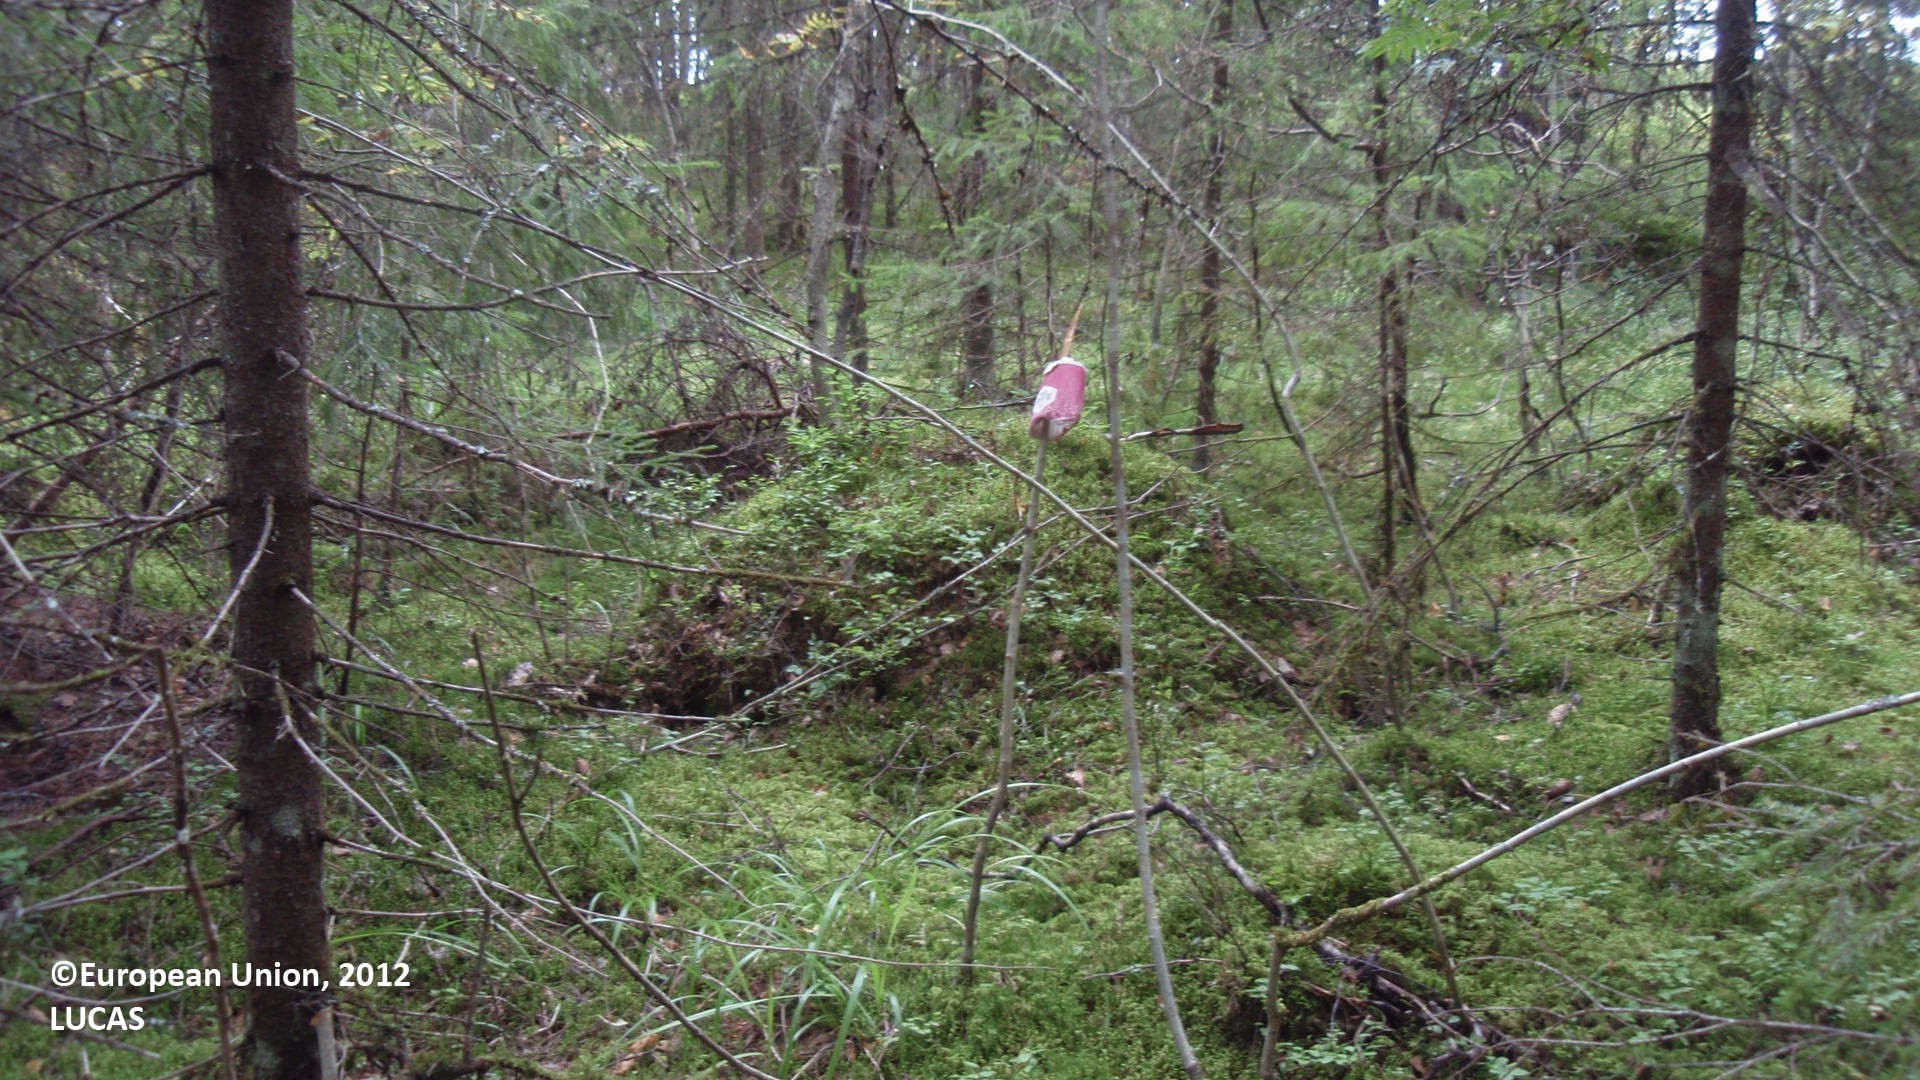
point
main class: Woodland
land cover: Spruce dominated mixed woodland
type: boreal forest
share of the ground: 50 - 75 %
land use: Forestry
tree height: > 5 m
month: August
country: FI
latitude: 60.8375
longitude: 27.4571
